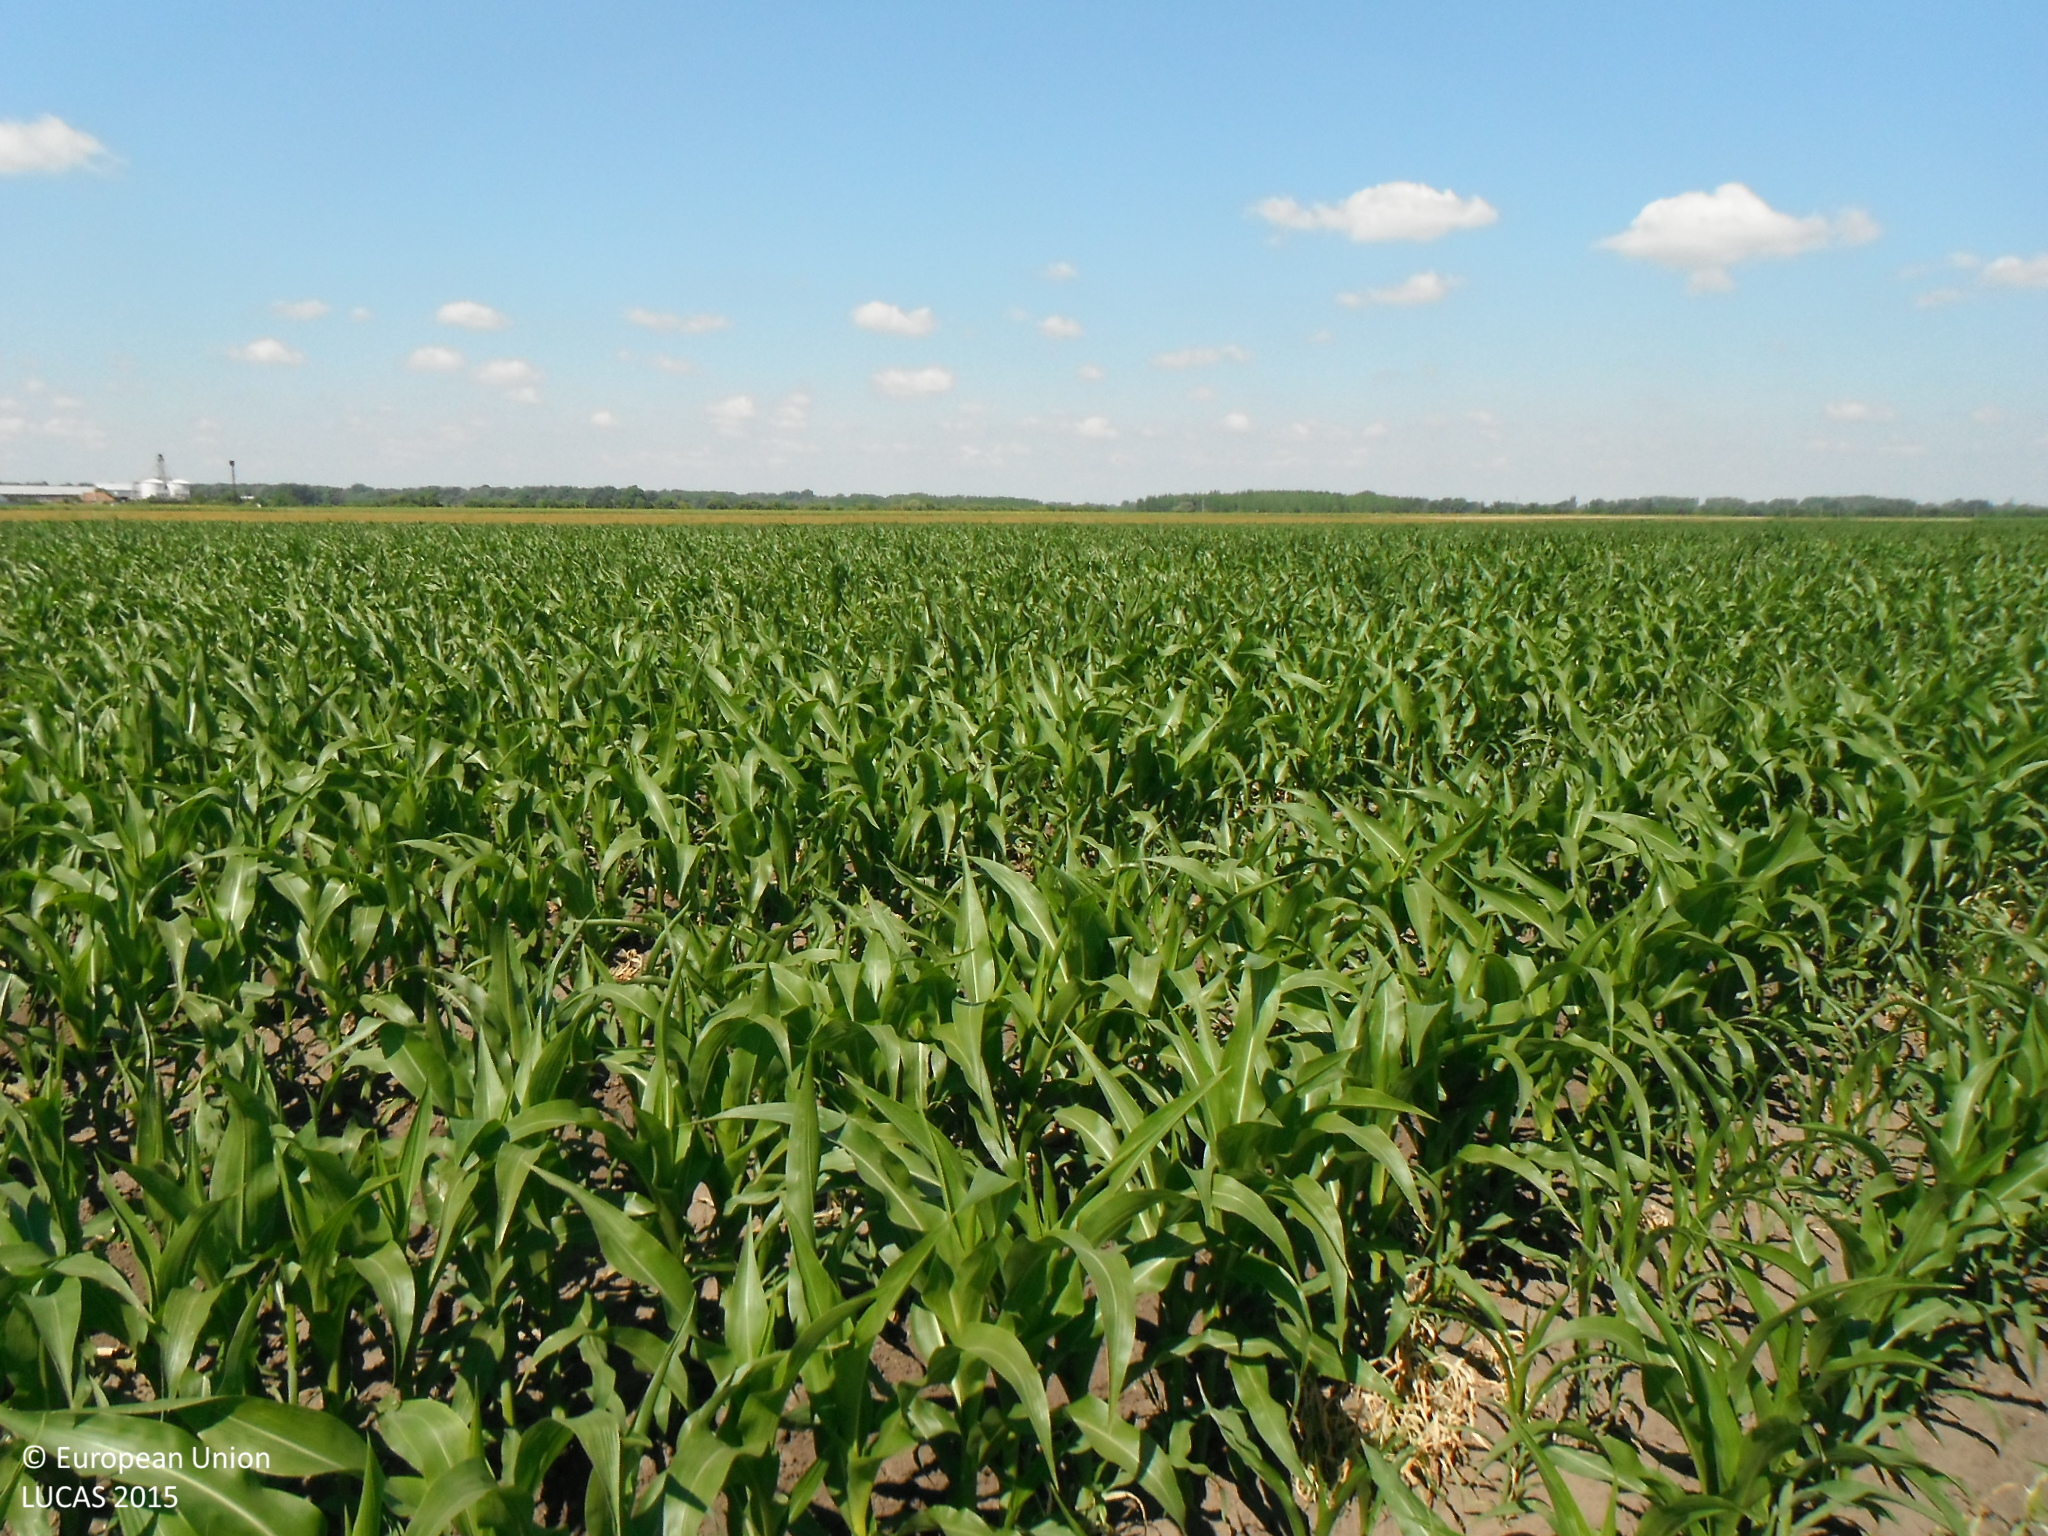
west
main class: Cropland
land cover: Maize
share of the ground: 50 - 75 %
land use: Agriculture (excluding fallow land and kitchen gardens)
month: June
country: SK
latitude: 47.7934
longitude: 18.1693
